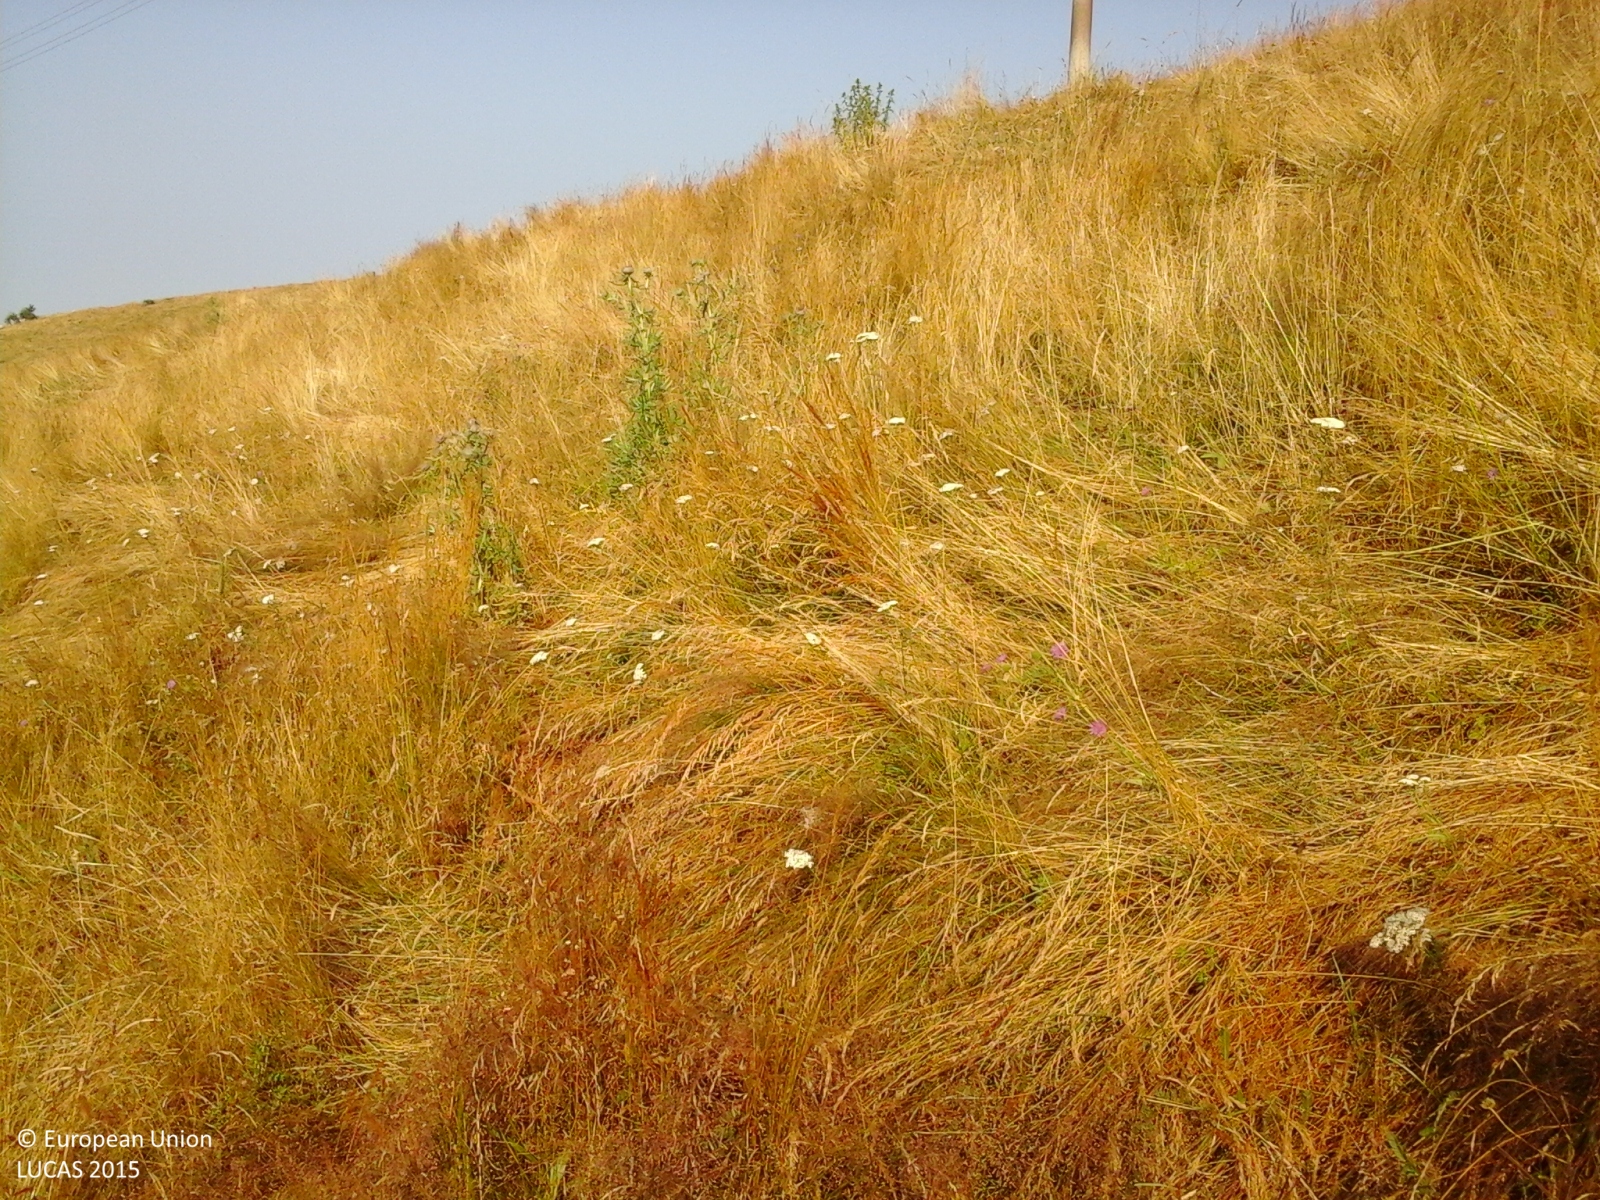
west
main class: Grassland
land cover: Grassland without tree/shrub cover
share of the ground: > 75 %
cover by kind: herbaceous plants 100 %
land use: Agriculture (excluding fallow land and kitchen gardens)
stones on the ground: 10 - 25 %
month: July
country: IT
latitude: 45.6430
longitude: 11.0888
